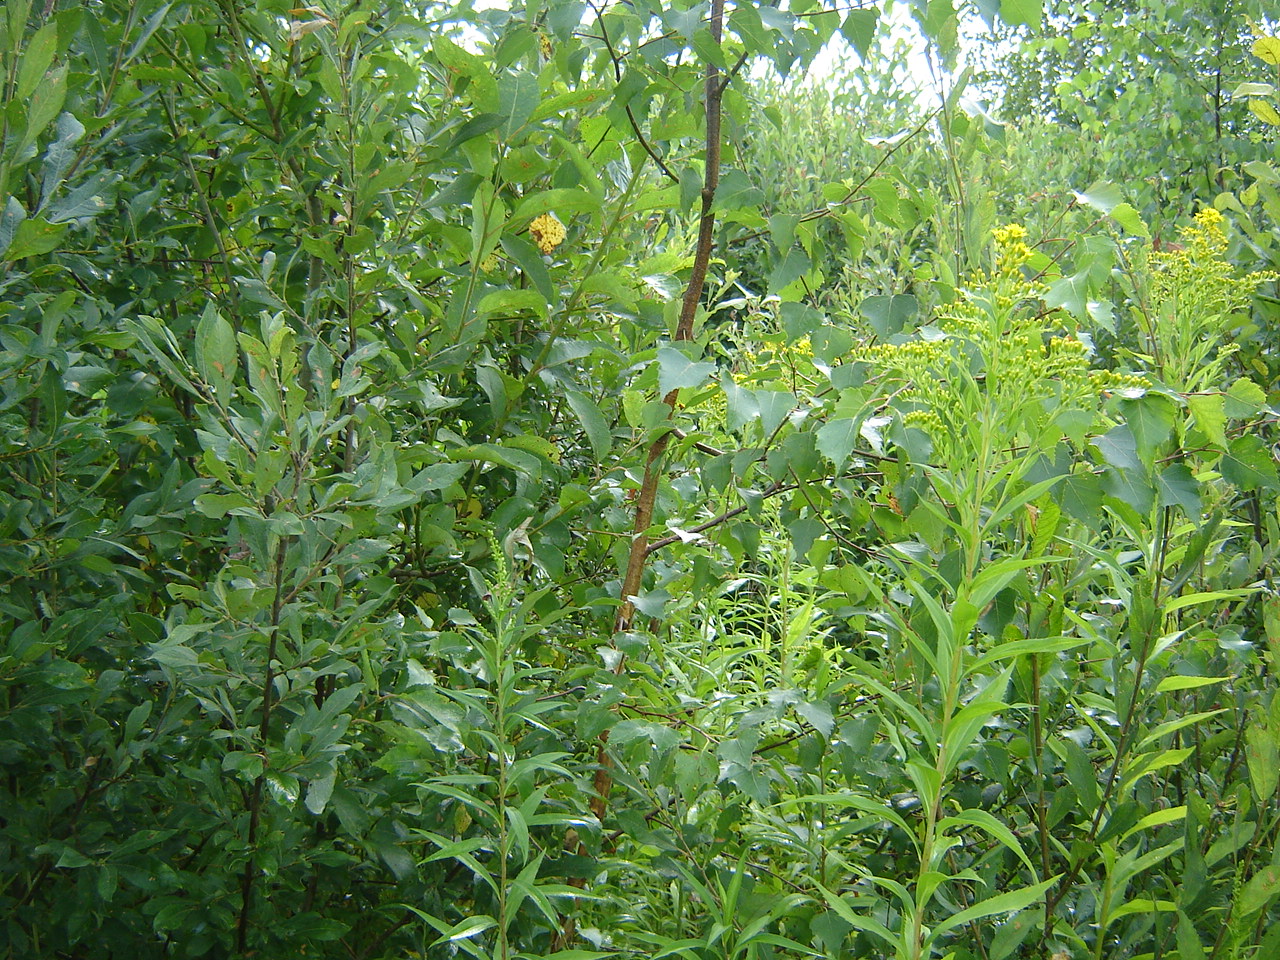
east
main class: Woodland
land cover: Broadleaved woodland
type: non-riverine alder, birch or aspen forest
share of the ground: > 75 %
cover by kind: broadleaved forest trees 90 %, coniferous forest trees 10 %
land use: Forestry
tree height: < 5 m
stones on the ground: < 10 %
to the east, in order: Broadleaved woodland; Spontaneously vegetated surfaces; Spruce dominated mixed woodland; Broadleaved woodland
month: August
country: LT
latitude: 54.9625
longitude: 24.9018
